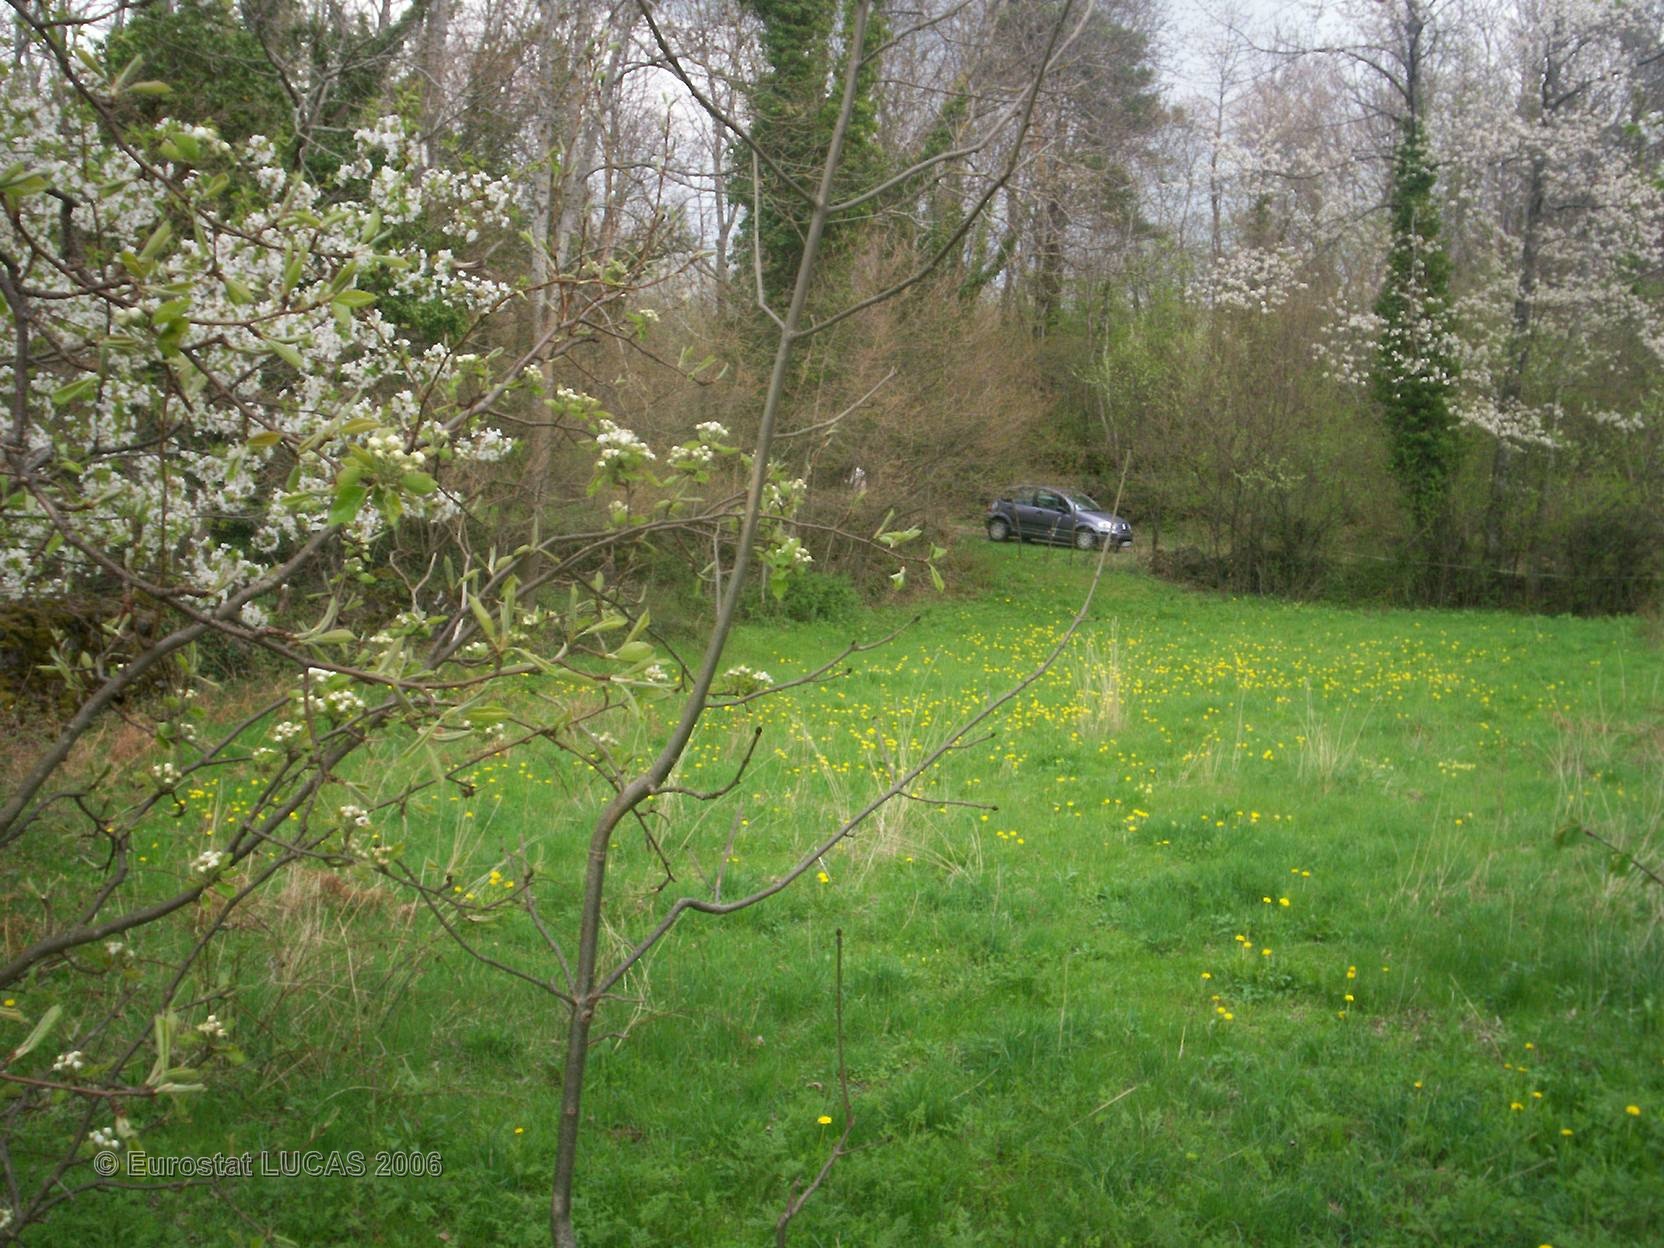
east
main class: Woodland
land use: Unused
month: April
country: FR
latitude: 45.5770
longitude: 2.9644
